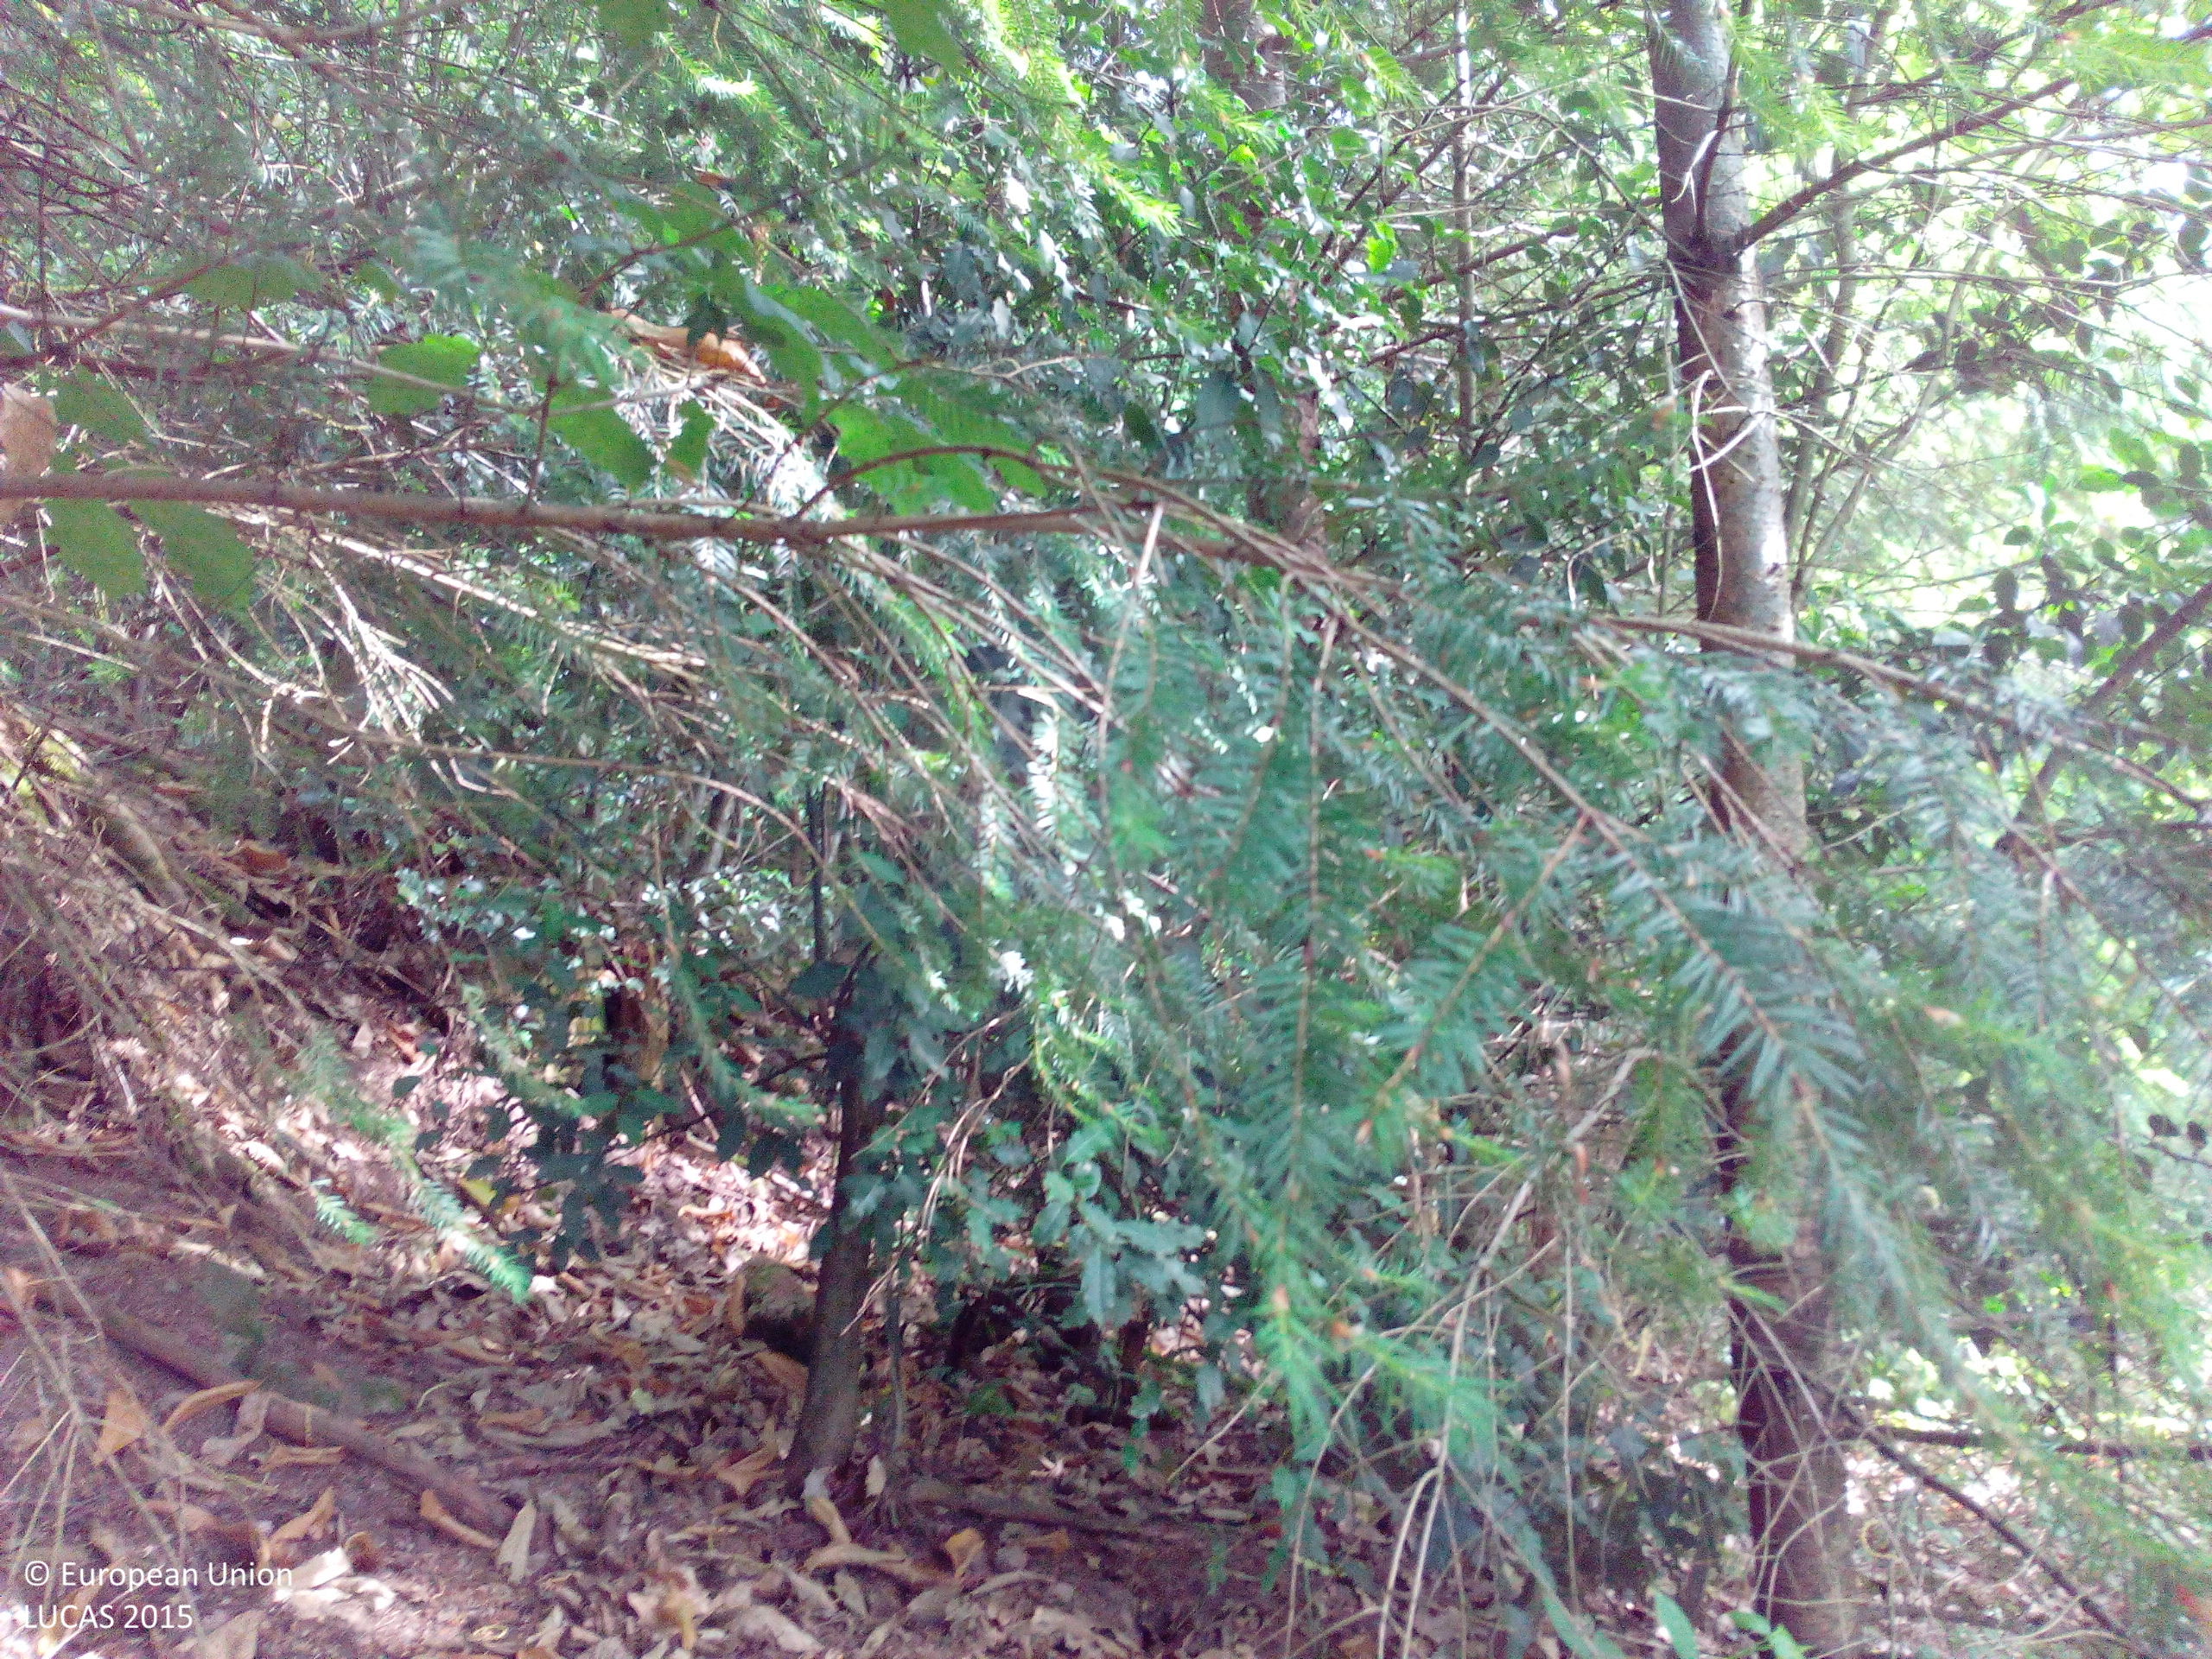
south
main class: Woodland
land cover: Spruce dominated mixed woodland
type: hemiboreal forest and nemoral coniferous forest and mixed broadleaved-coniferous forest
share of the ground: > 75 %
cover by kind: coniferous forest trees 60 %, broadleaved forest trees 40 %
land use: Forestry
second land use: Amenities, museums, leisure
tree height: > 5 m
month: June
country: DE
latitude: 48.7307
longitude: 8.1925
